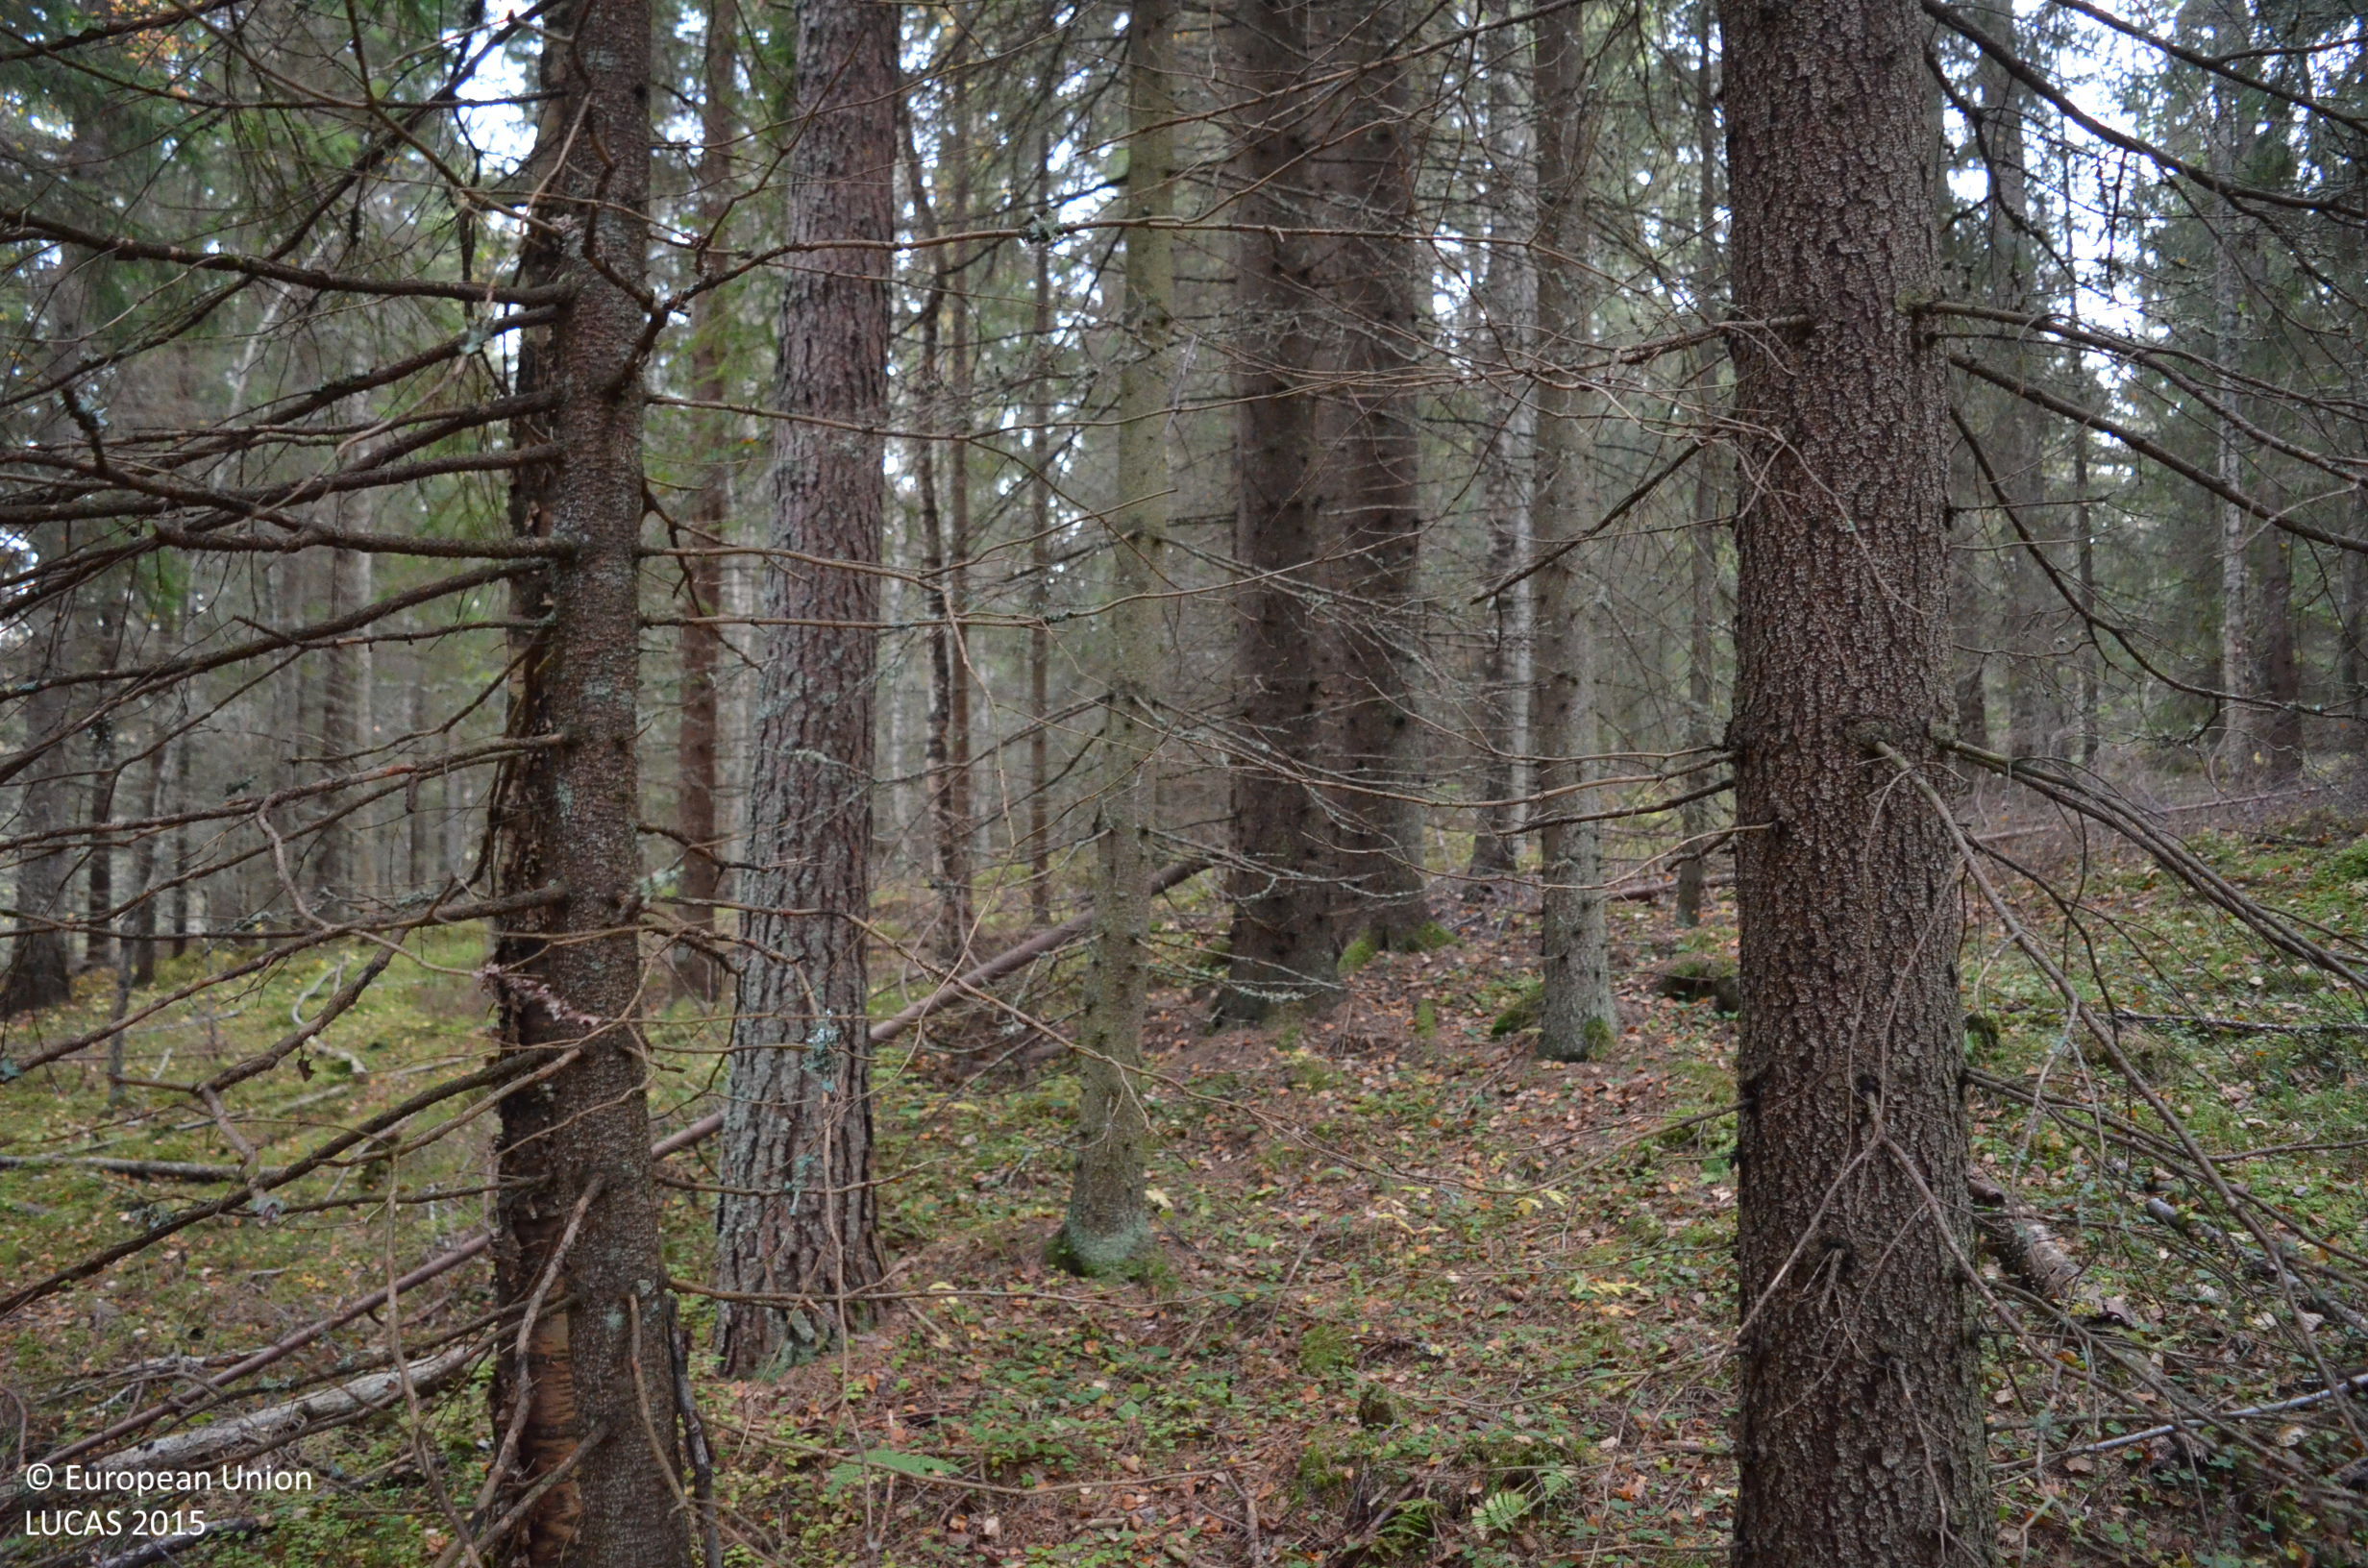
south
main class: Woodland
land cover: Spruce dominated coniferous woodland
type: boreal forest
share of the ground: > 75 %
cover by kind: coniferous forest trees 70 %, broadleaved forest trees 10 %, shrubs 5 %, herbaceous plants 5 %, lichens and mosses 5 %
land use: Forestry
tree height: > 5 m
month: October
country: FI
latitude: 61.8710
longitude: 23.9065
